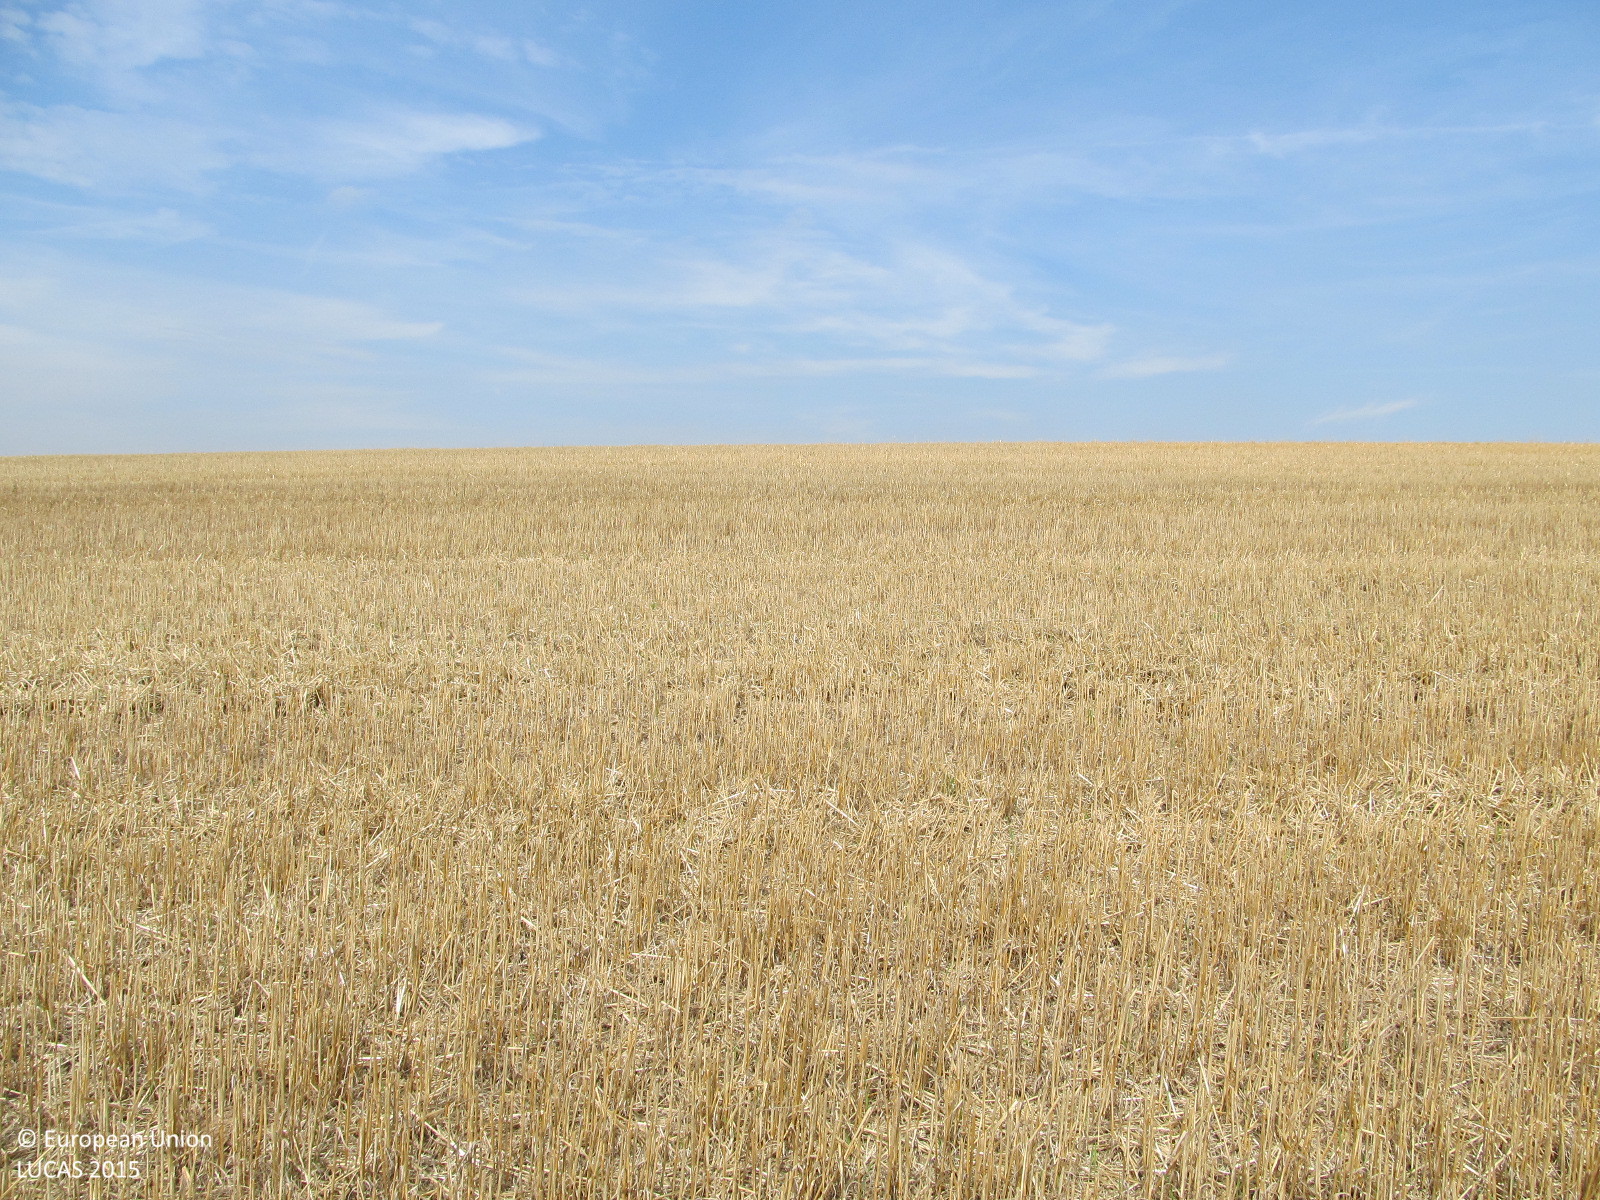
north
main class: Cropland
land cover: Common wheat
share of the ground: 25 - 50 %
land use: Agriculture (excluding fallow land and kitchen gardens)
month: August
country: AT
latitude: 48.8646
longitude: 15.4422
